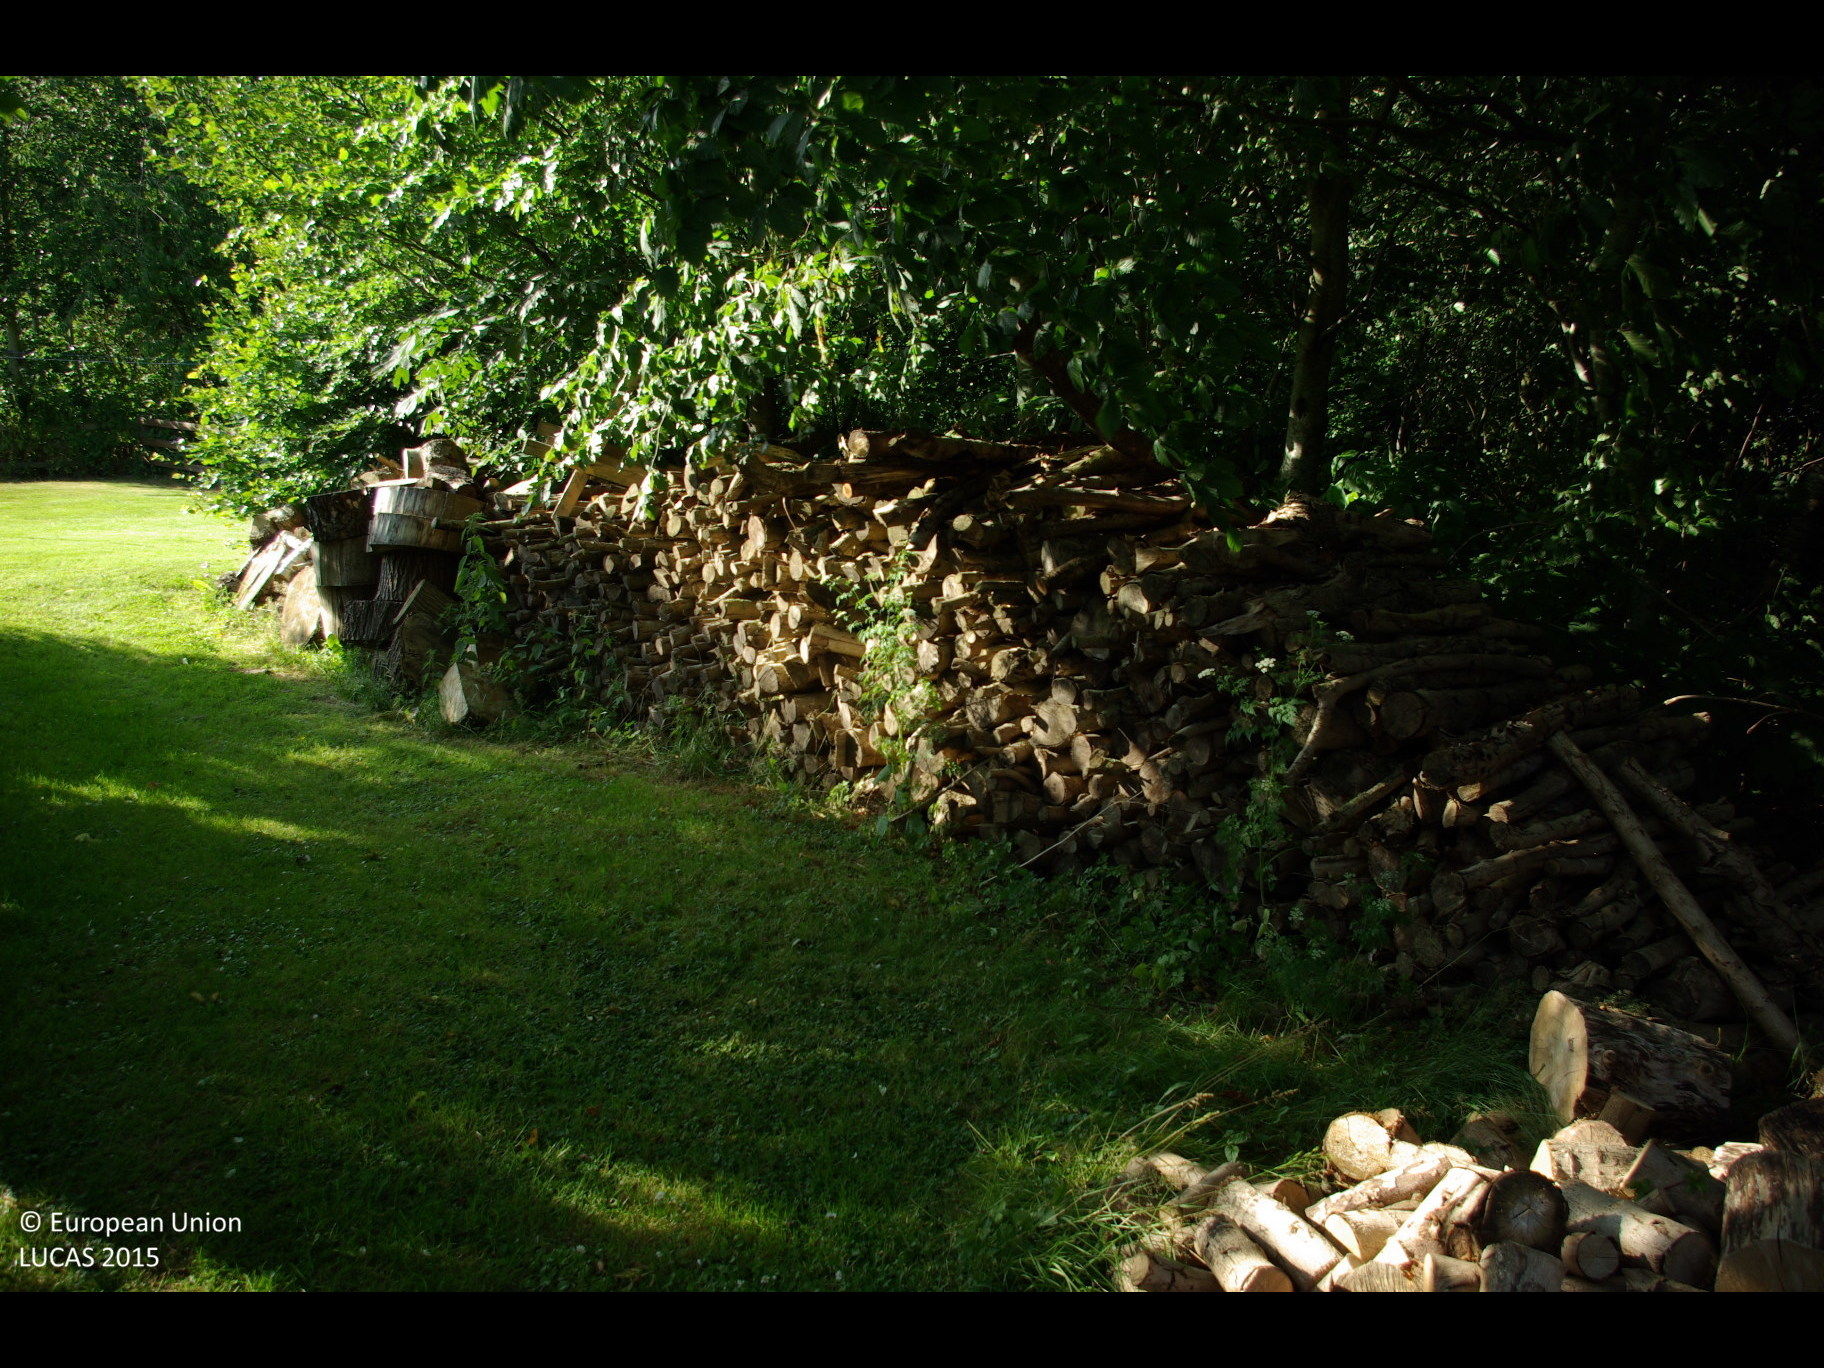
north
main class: Grassland
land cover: Grassland without tree/shrub cover
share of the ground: > 75 %
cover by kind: herbaceous plants 100 %
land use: Residential
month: July
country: DE
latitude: 54.7138
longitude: 9.8604
